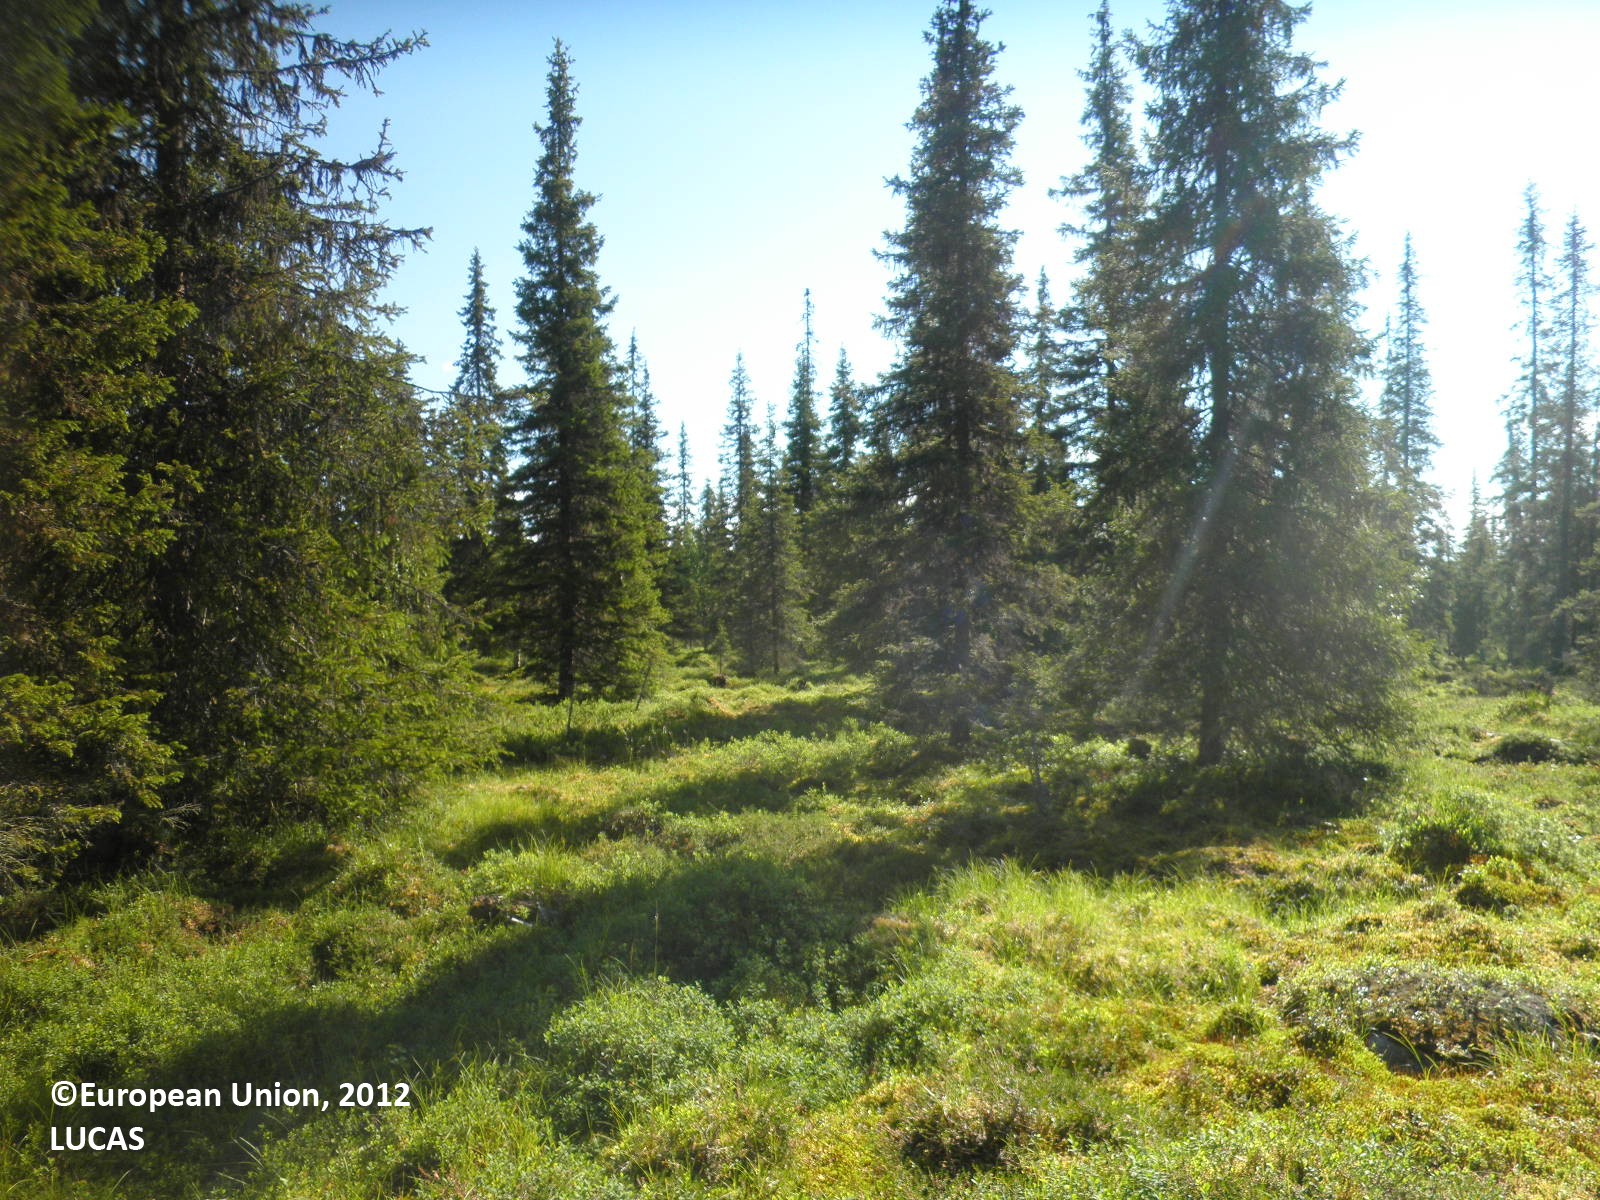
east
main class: Woodland
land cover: Spruce dominated mixed woodland
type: boreal forest
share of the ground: 25 - 50 %
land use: Forestry
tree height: > 5 m
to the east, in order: Spruce dominated mixed woodland; Spruce dominated coniferous woodland
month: July
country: FI
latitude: 67.7126
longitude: 26.2471
